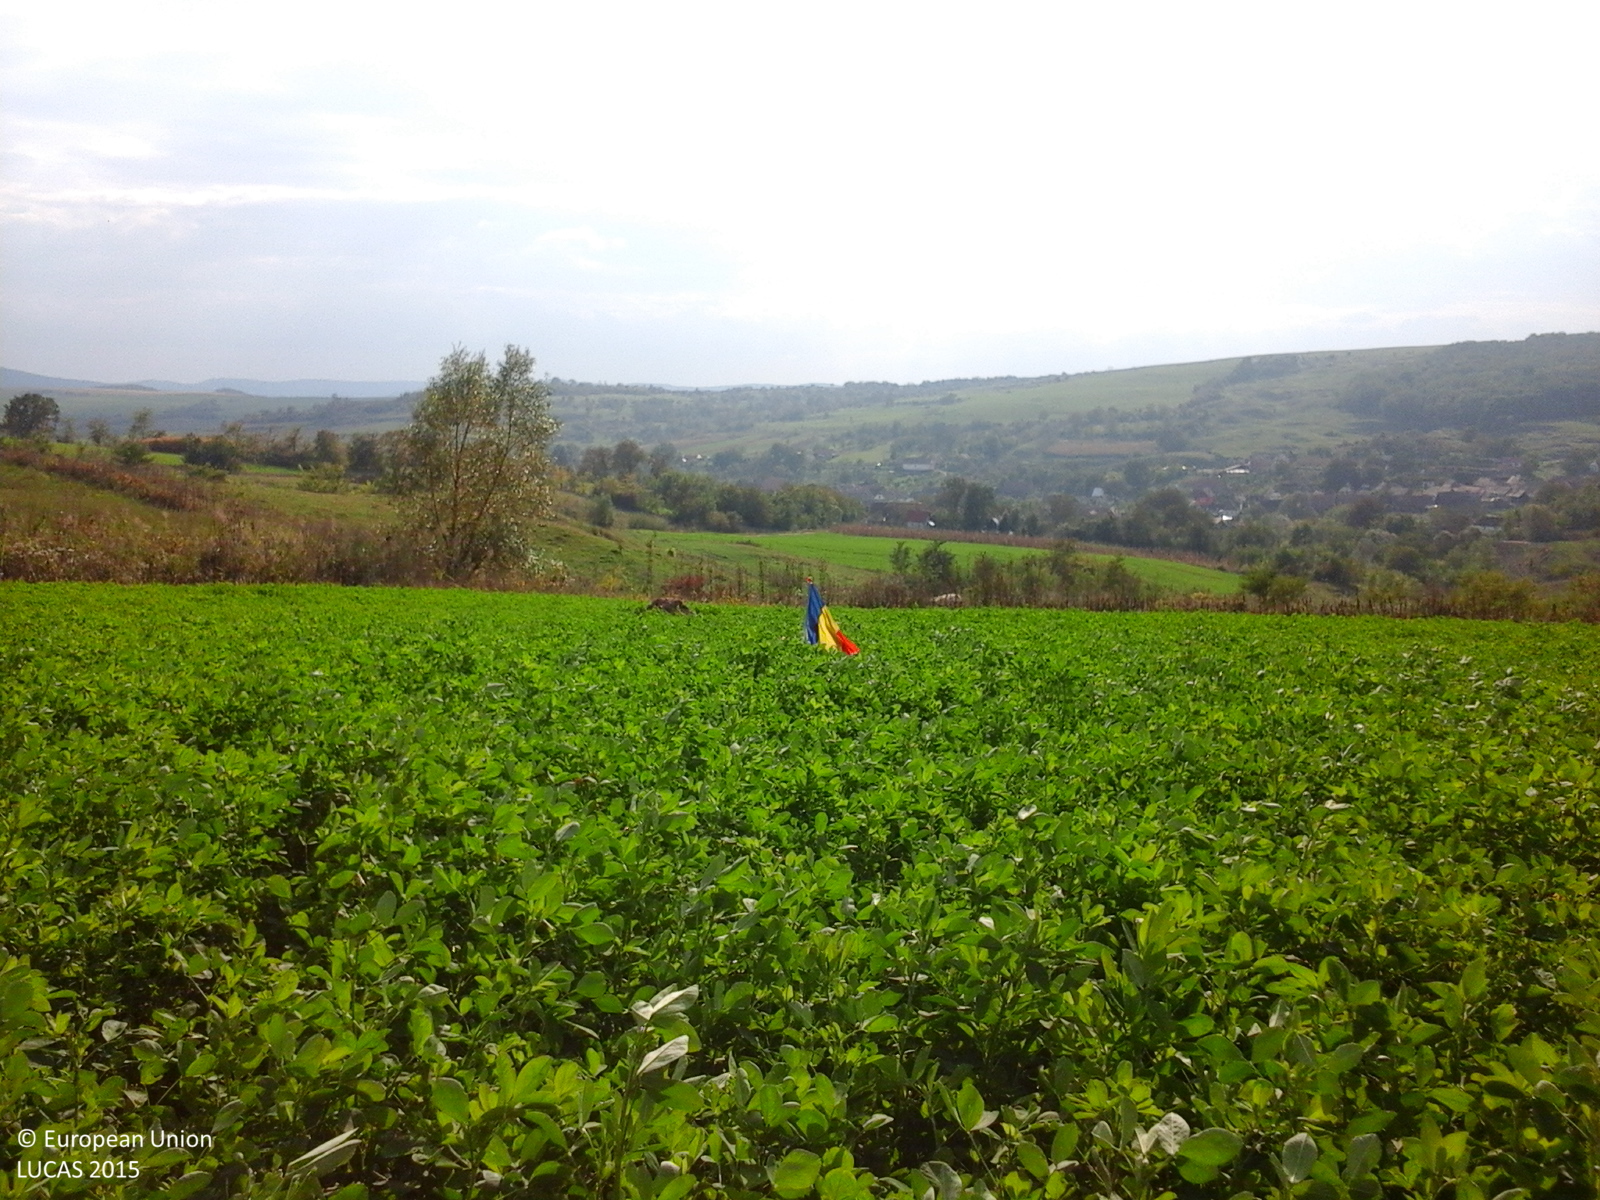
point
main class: Cropland
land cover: Lucerne
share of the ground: > 75 %
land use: Agriculture (excluding fallow land and kitchen gardens)
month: October
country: RO
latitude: 46.2458
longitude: 24.2828
